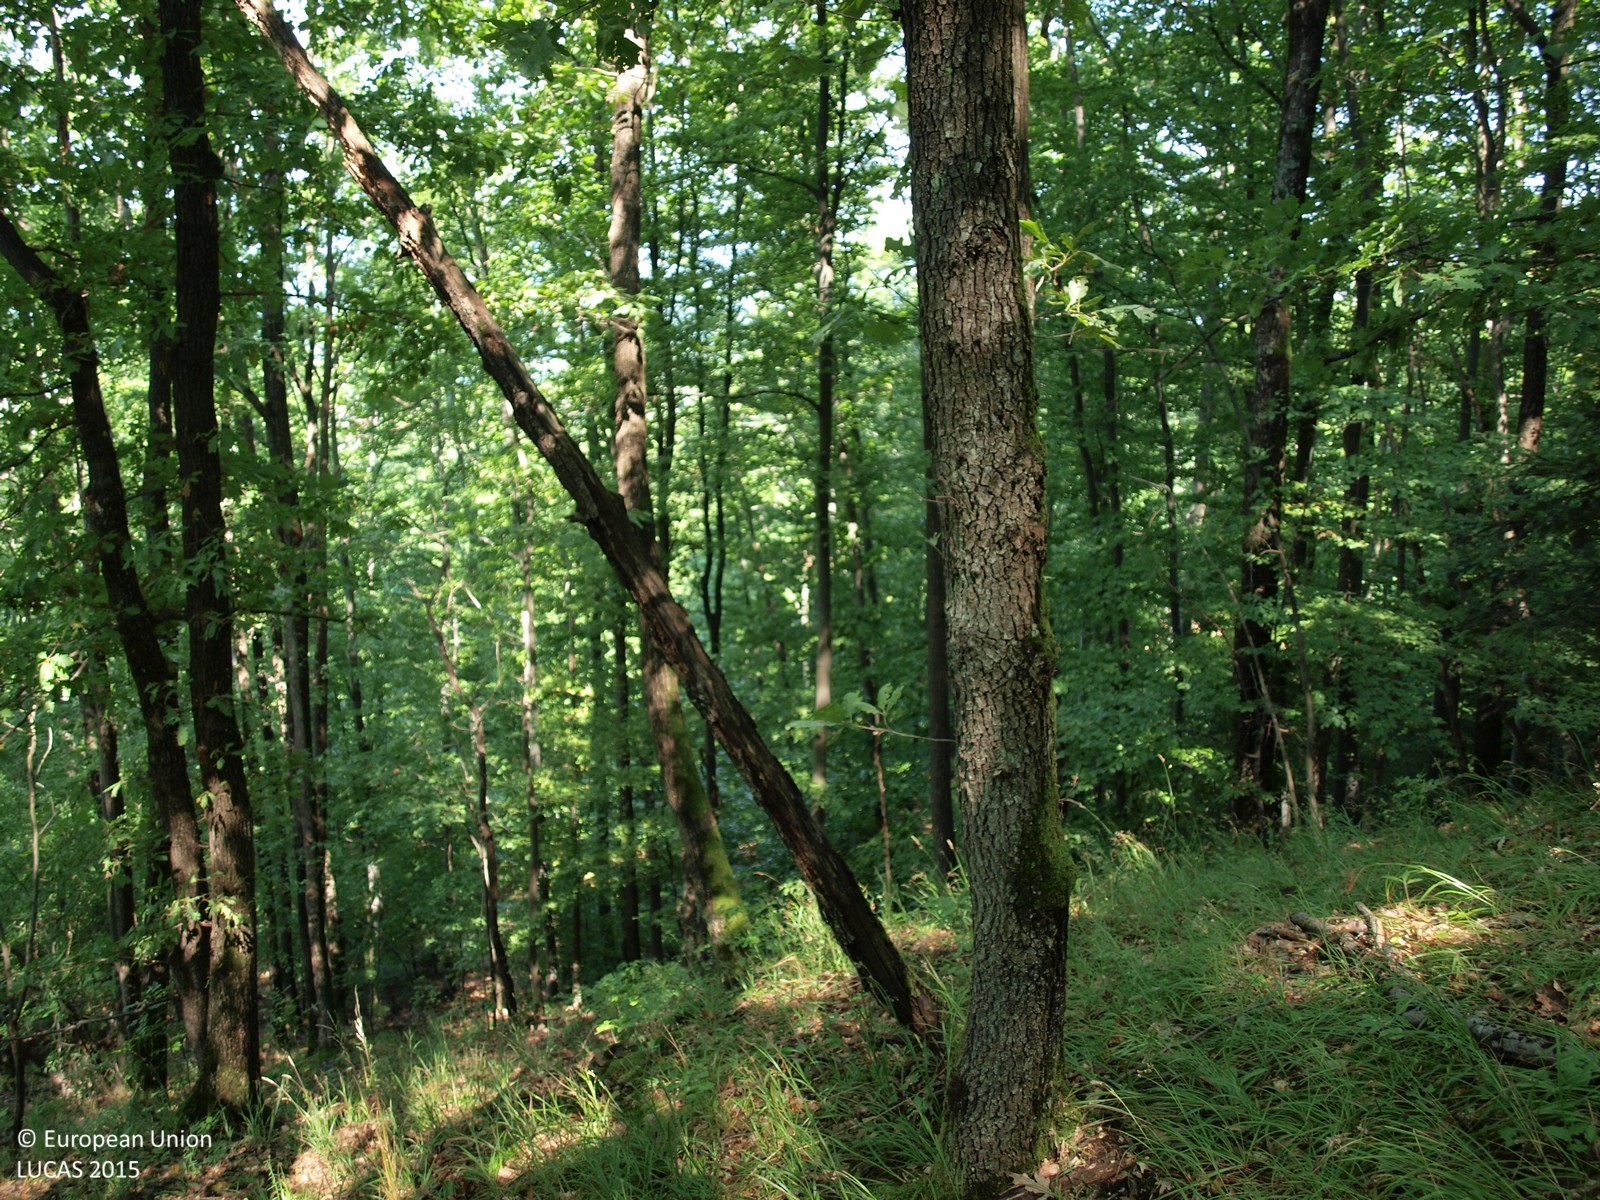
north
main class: Woodland
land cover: Broadleaved woodland
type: mesophytic deciduous forest
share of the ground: > 75 %
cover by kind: broadleaved forest trees 100 %
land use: Forestry
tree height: > 5 m
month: July
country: HR
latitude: 45.9166
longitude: 15.9160
